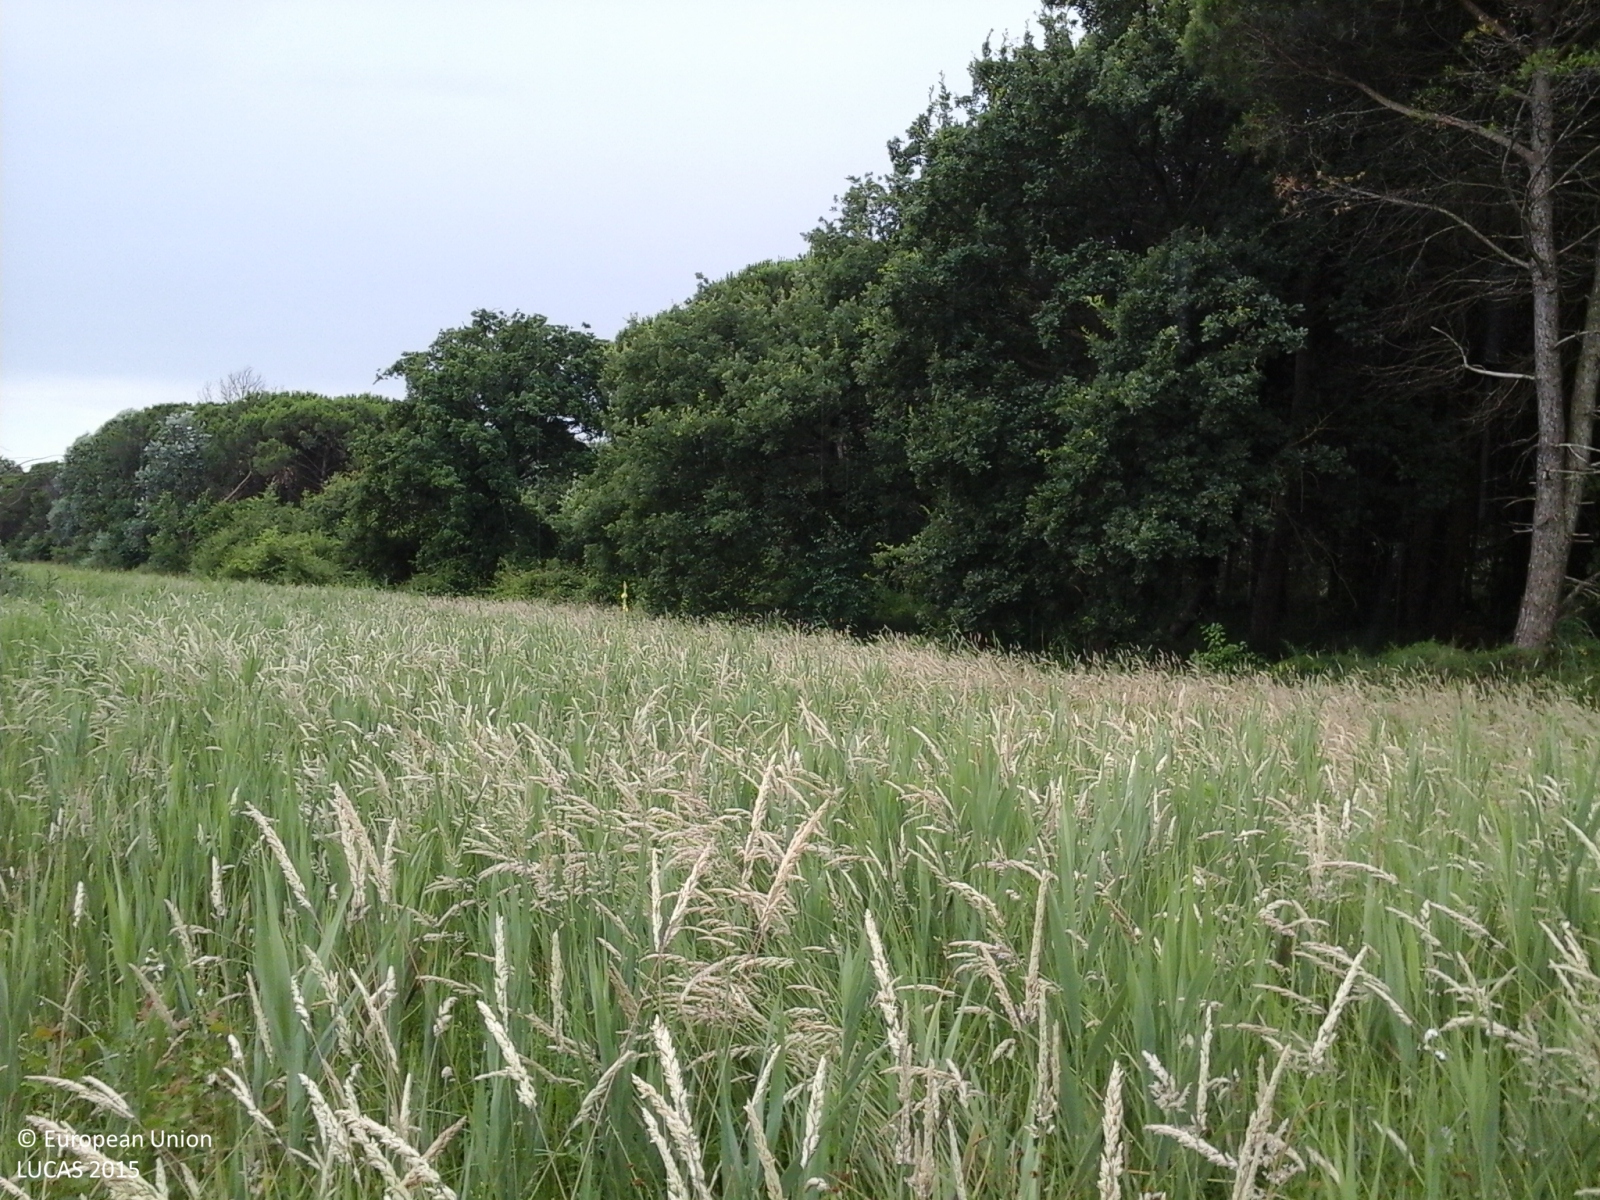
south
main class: Grassland
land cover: Grassland without tree/shrub cover
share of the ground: > 75 %
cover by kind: herbaceous plants 100 %
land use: Agriculture (excluding fallow land and kitchen gardens)
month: June
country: IT
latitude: 44.5968
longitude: 12.2505
